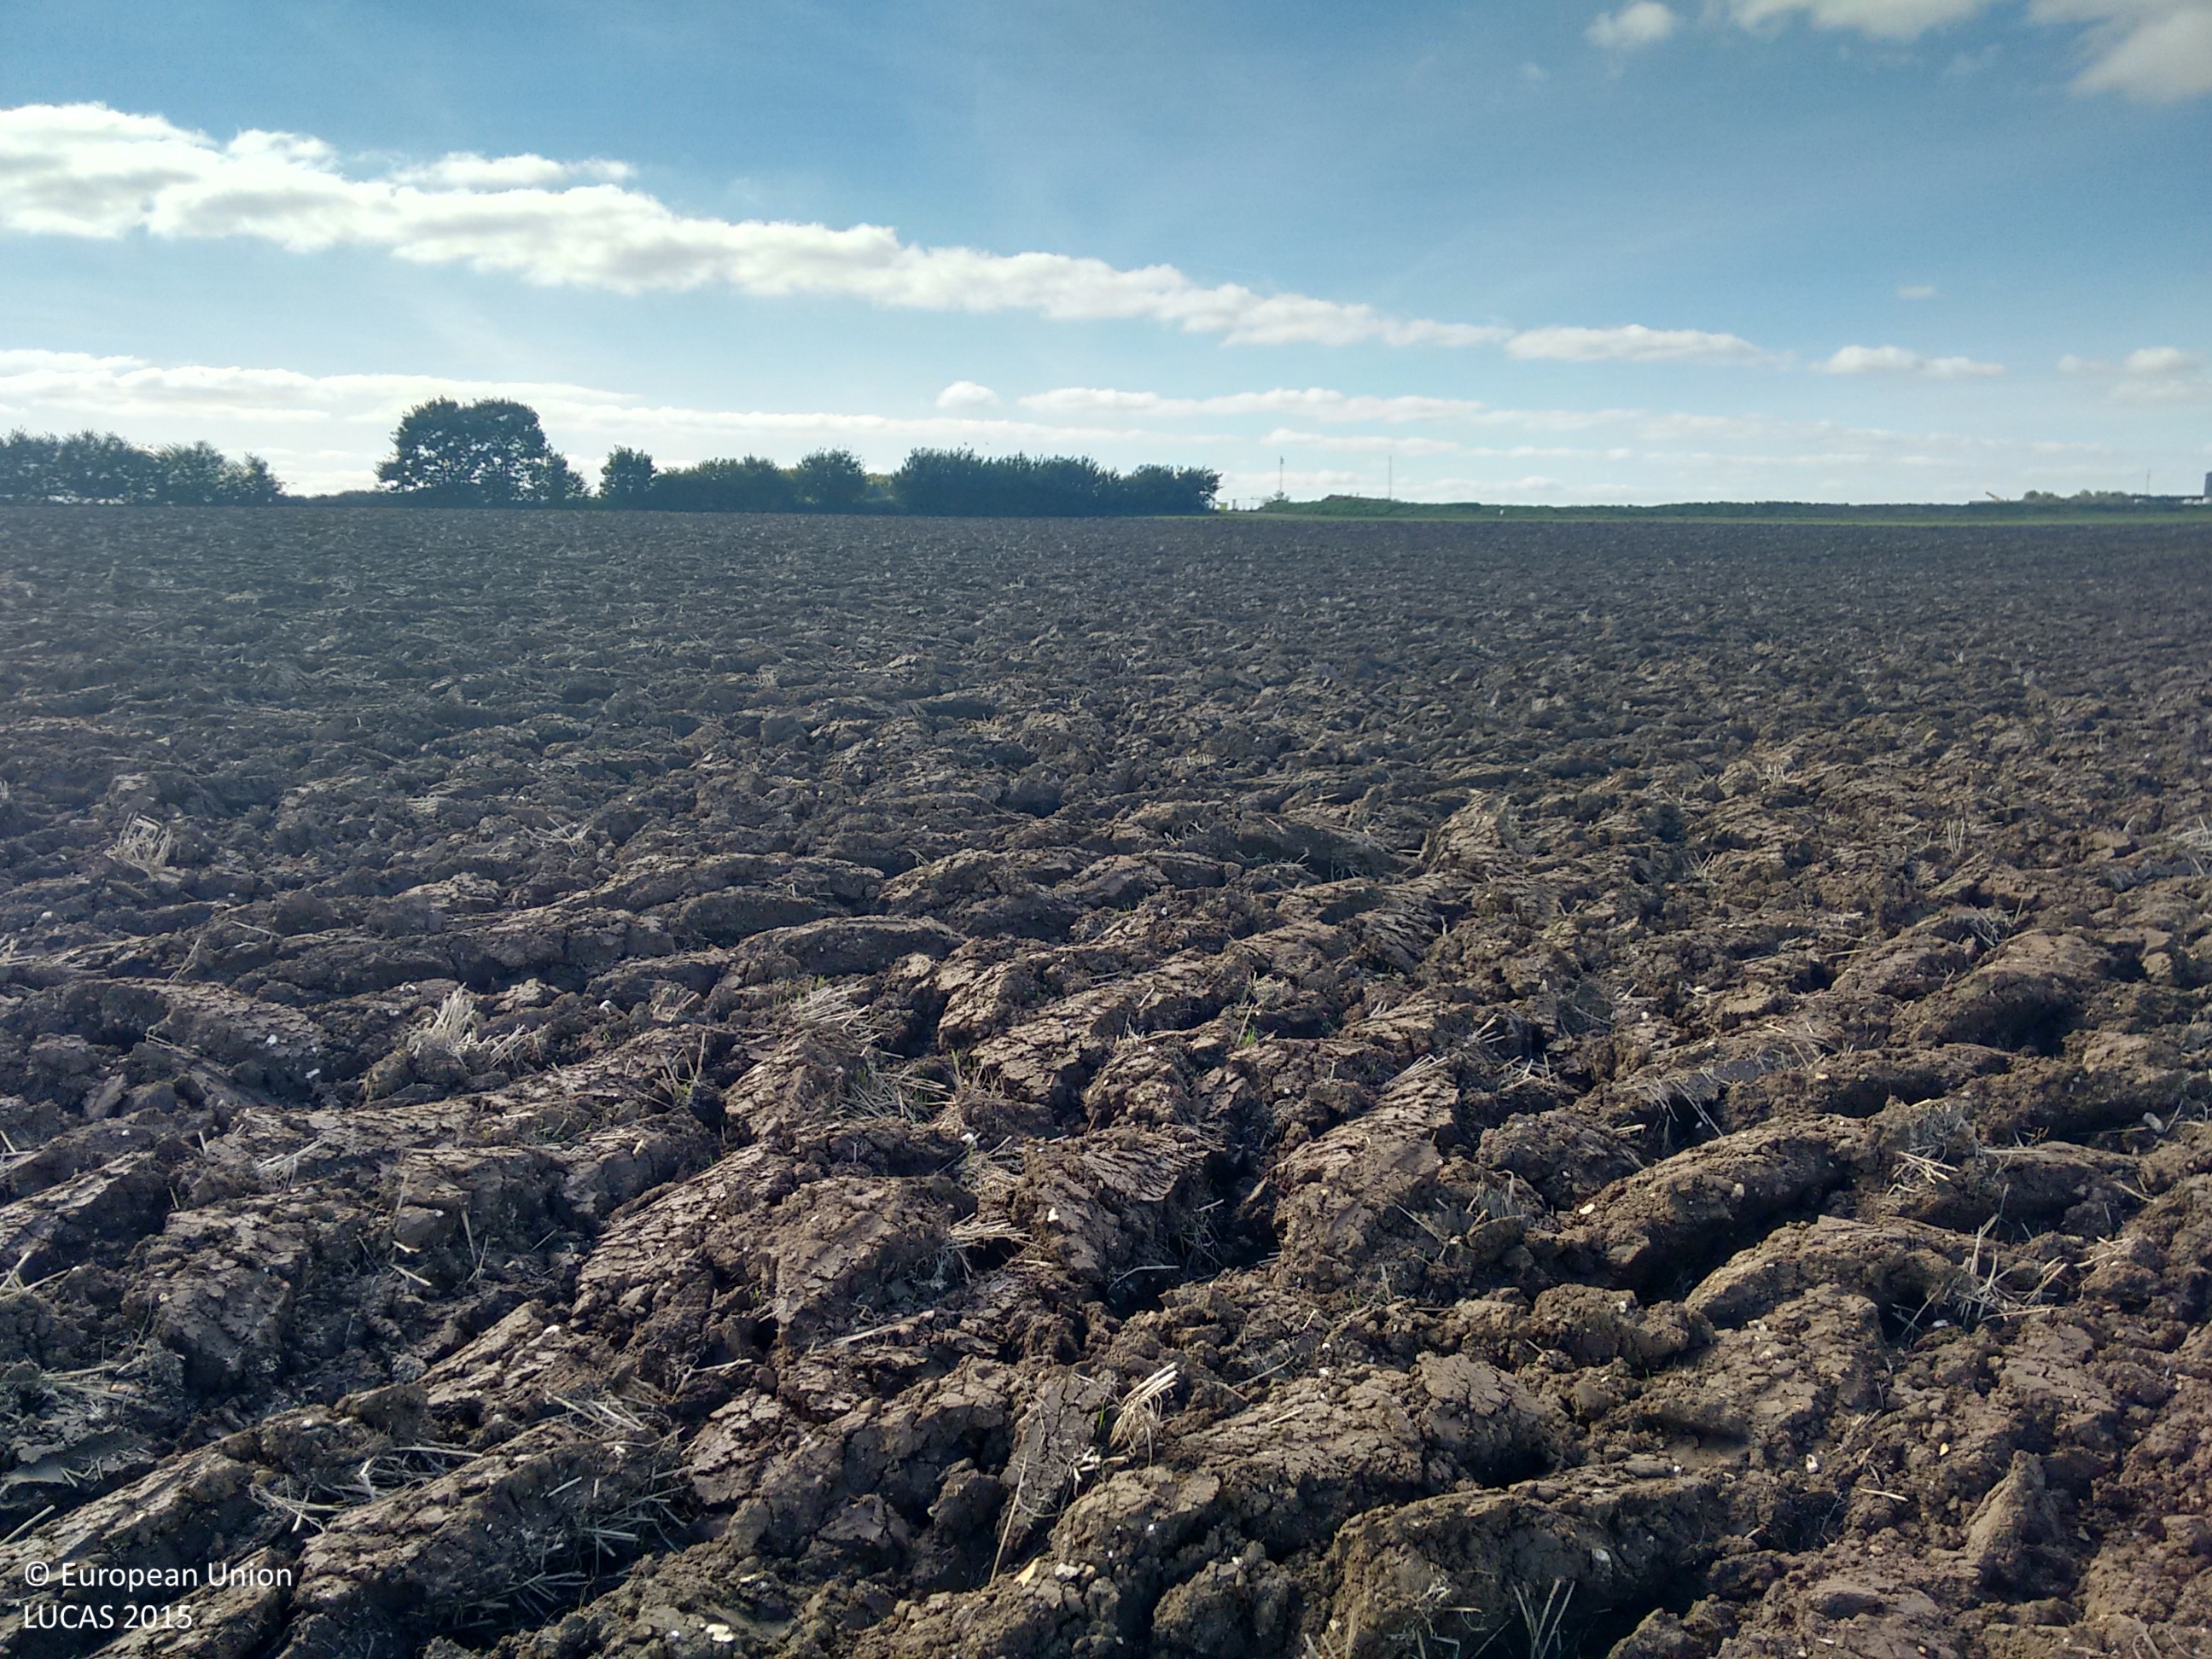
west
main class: Cropland
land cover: Common wheat
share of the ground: < 10 %
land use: Agriculture (excluding fallow land and kitchen gardens)
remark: Harvested field
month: September
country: GB
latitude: 51.9971
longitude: 0.0785
